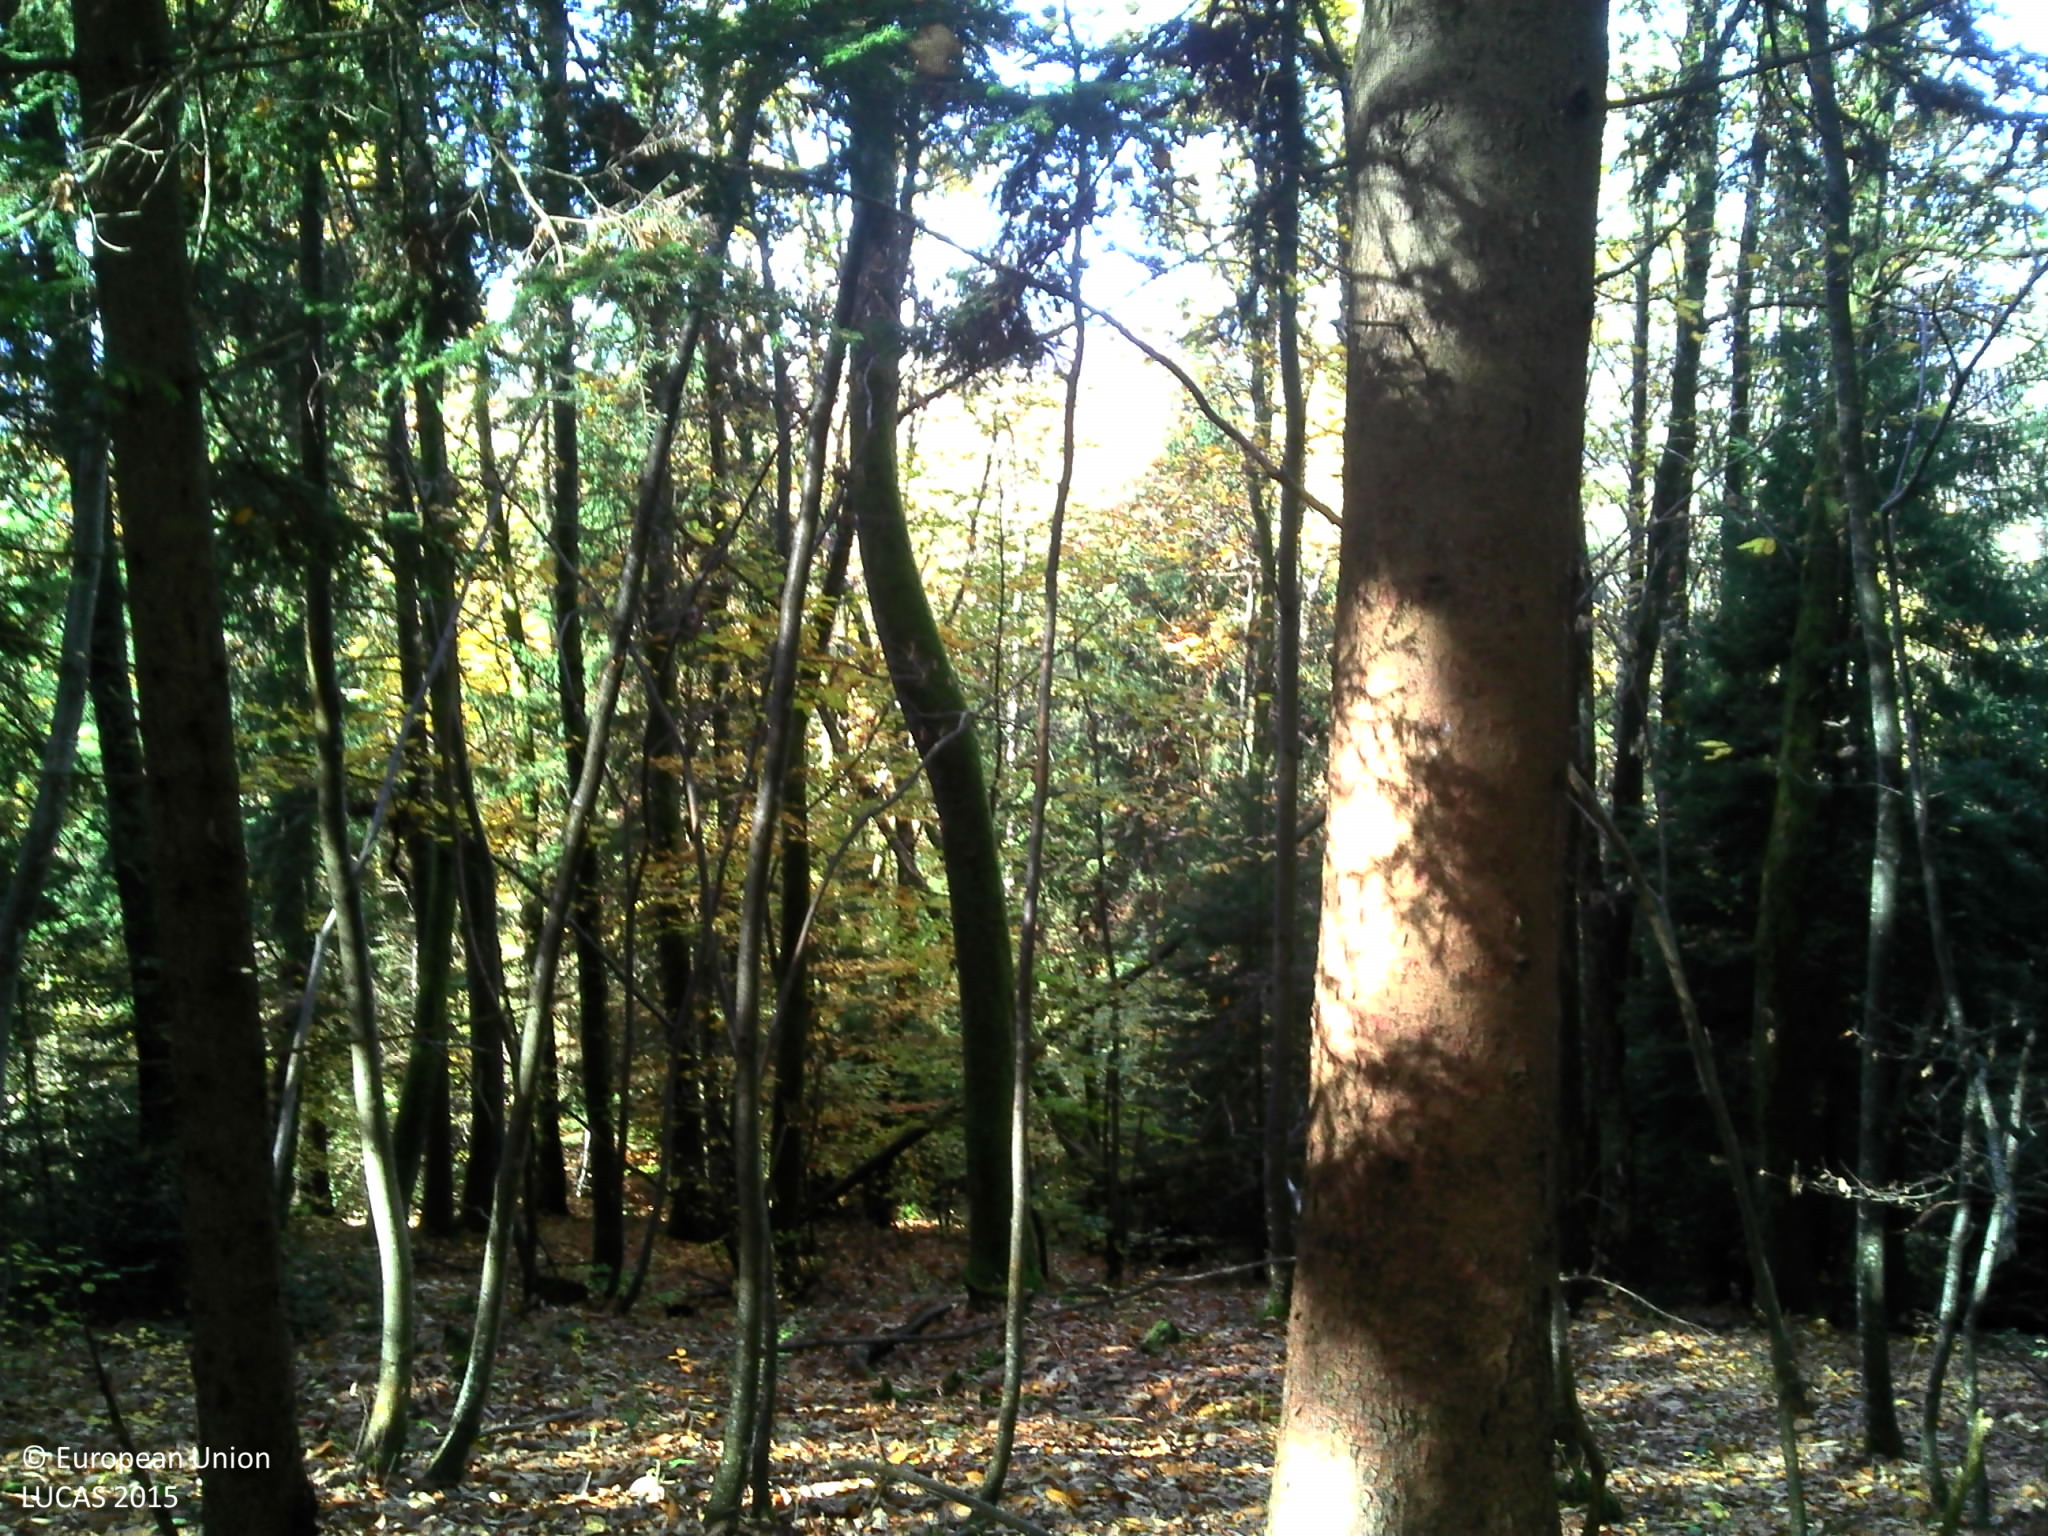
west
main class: Woodland
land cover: Spruce dominated mixed woodland
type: hemiboreal forest and nemoral coniferous forest and mixed broadleaved-coniferous forest
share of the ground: > 75 %
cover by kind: coniferous forest trees 45 %, broadleaved forest trees 45 %, unconsolidated bare surface 10 %
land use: Forestry
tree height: > 5 m
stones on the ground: < 10 %
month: October
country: FR
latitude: 45.4705
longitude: 6.1547
